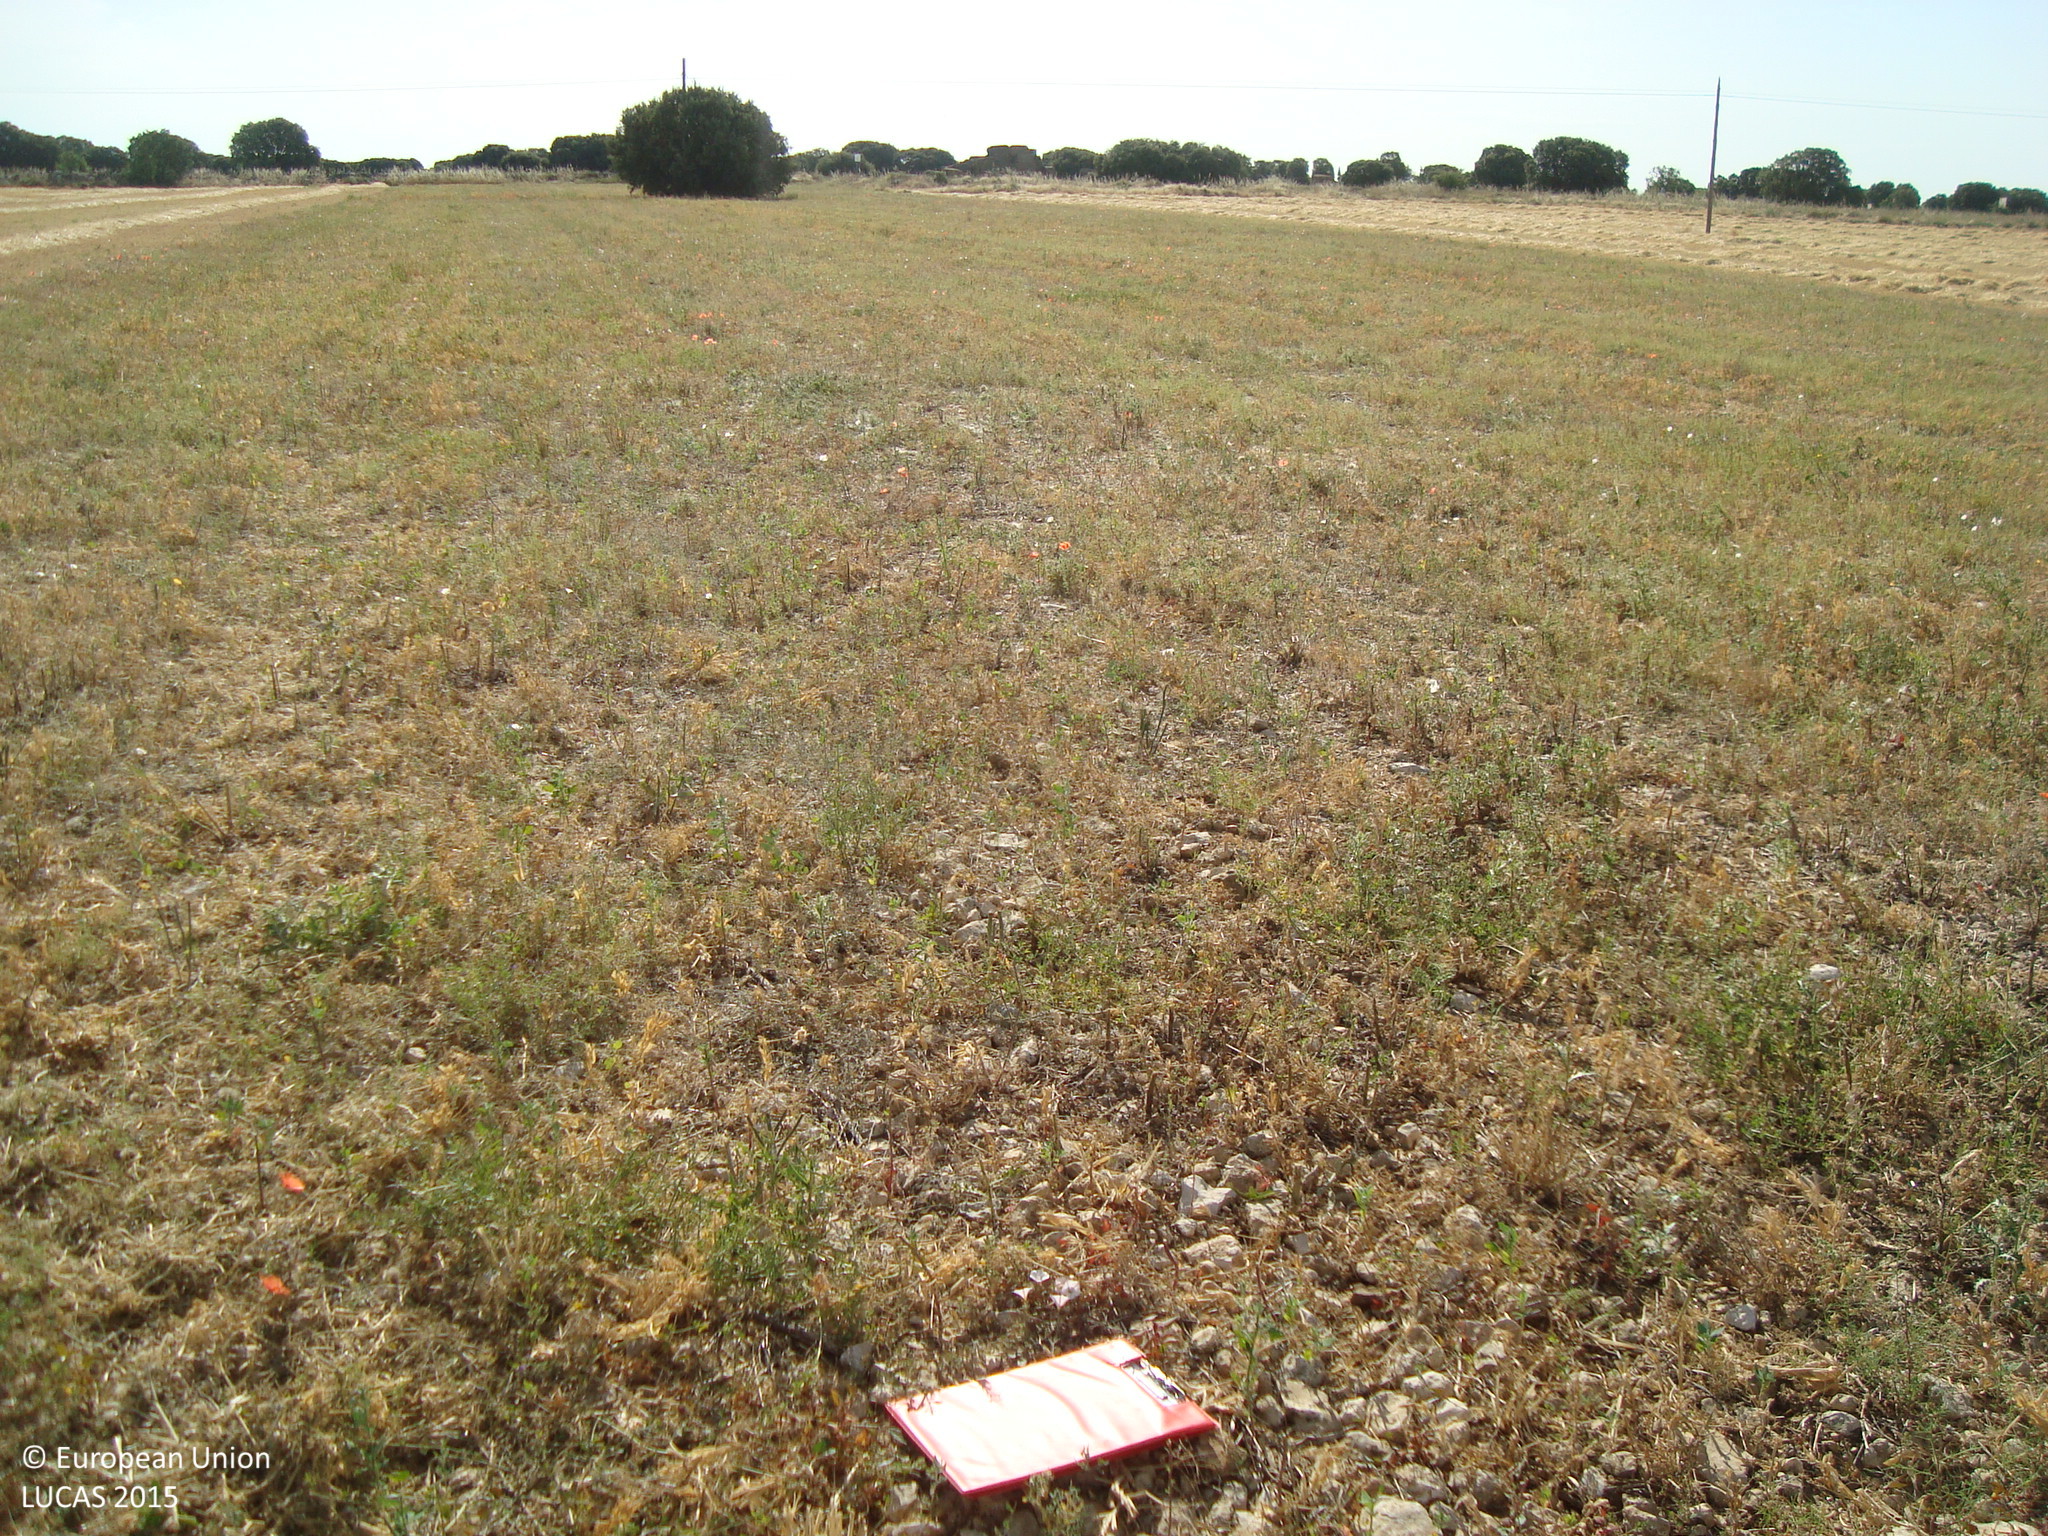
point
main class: Cropland
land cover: Dry pulses
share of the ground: 50 - 75 %
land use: Agriculture (excluding fallow land and kitchen gardens)
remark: Harvested field
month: July
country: ES
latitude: 41.8859
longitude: -4.1993
